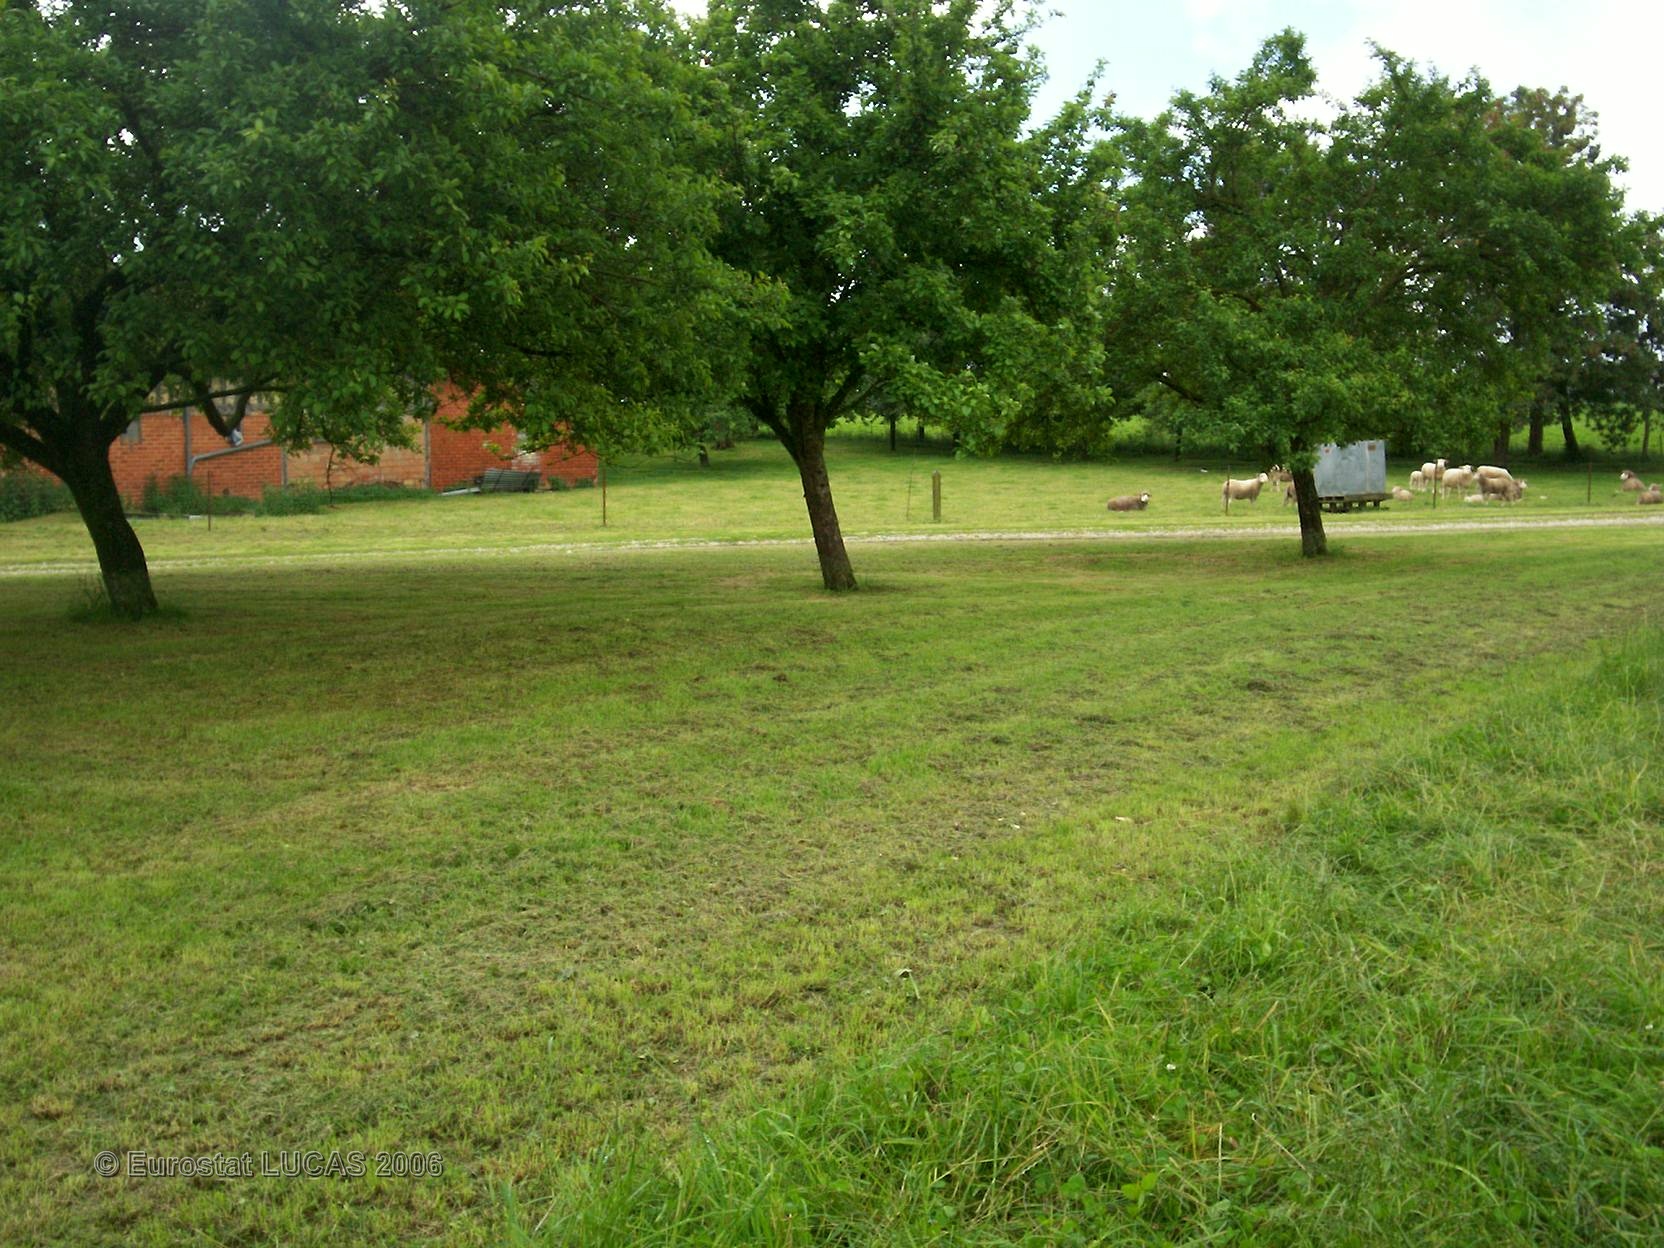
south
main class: Grassland
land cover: Grassland without tree/shrub cover
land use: Agriculture (excluding fallow land and kitchen gardens)
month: June
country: FR
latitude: 48.5530
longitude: 4.4560
